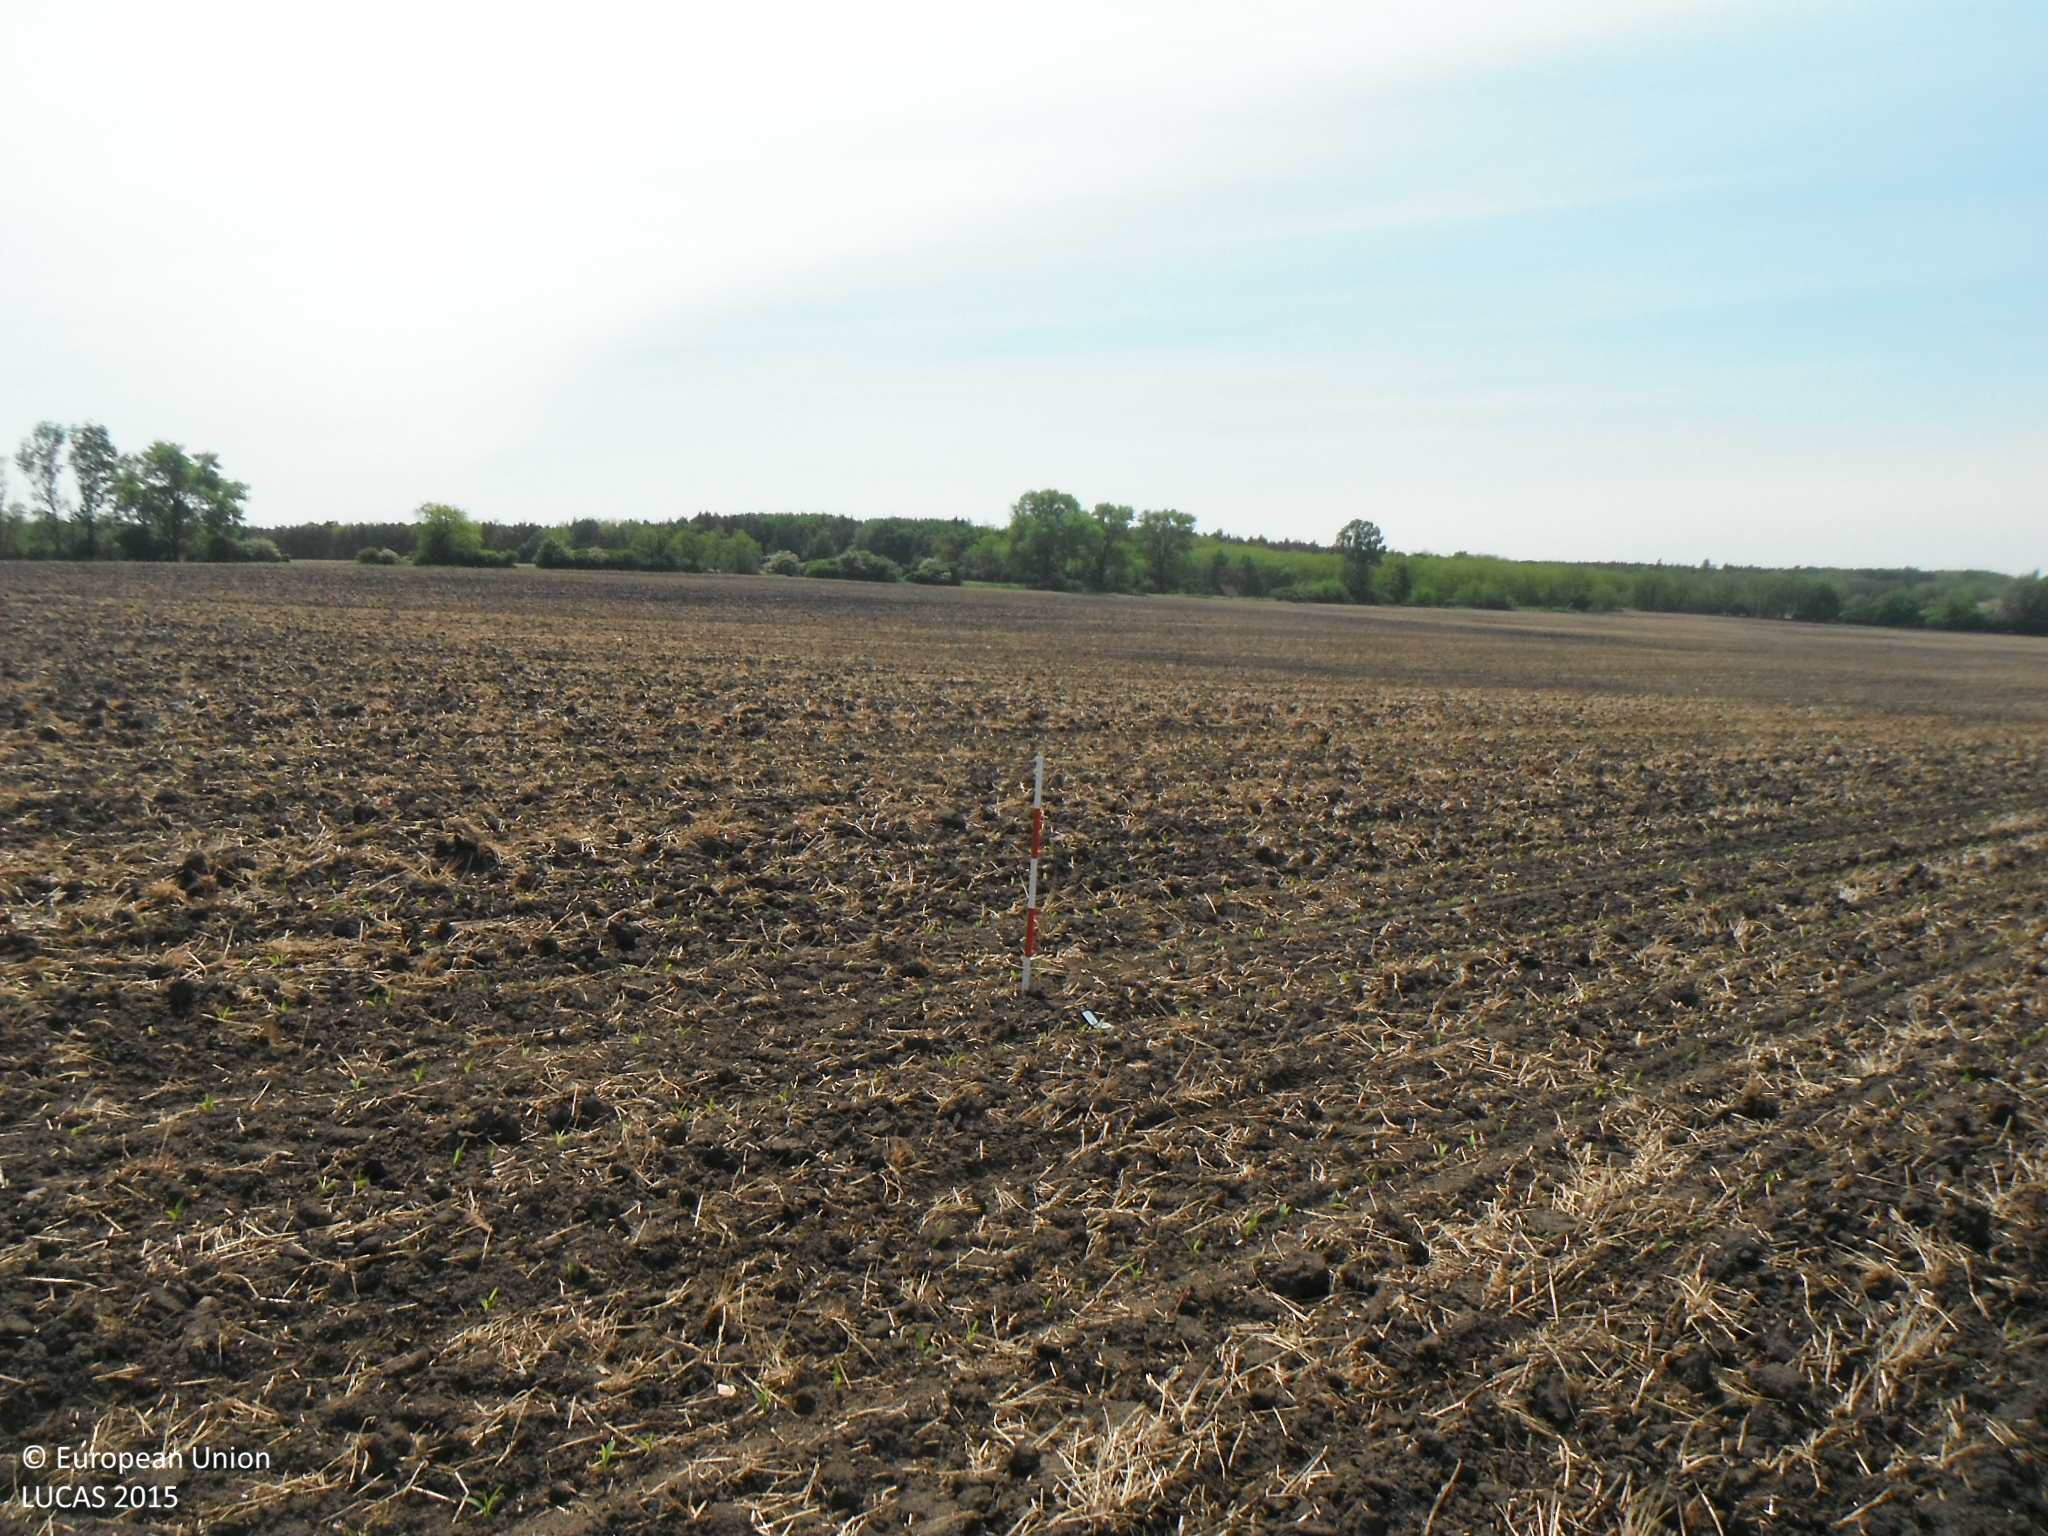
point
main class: Cropland
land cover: Maize
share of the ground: < 10 %
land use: Agriculture (excluding fallow land and kitchen gardens)
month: May
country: SK
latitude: 48.2718
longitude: 17.0004
